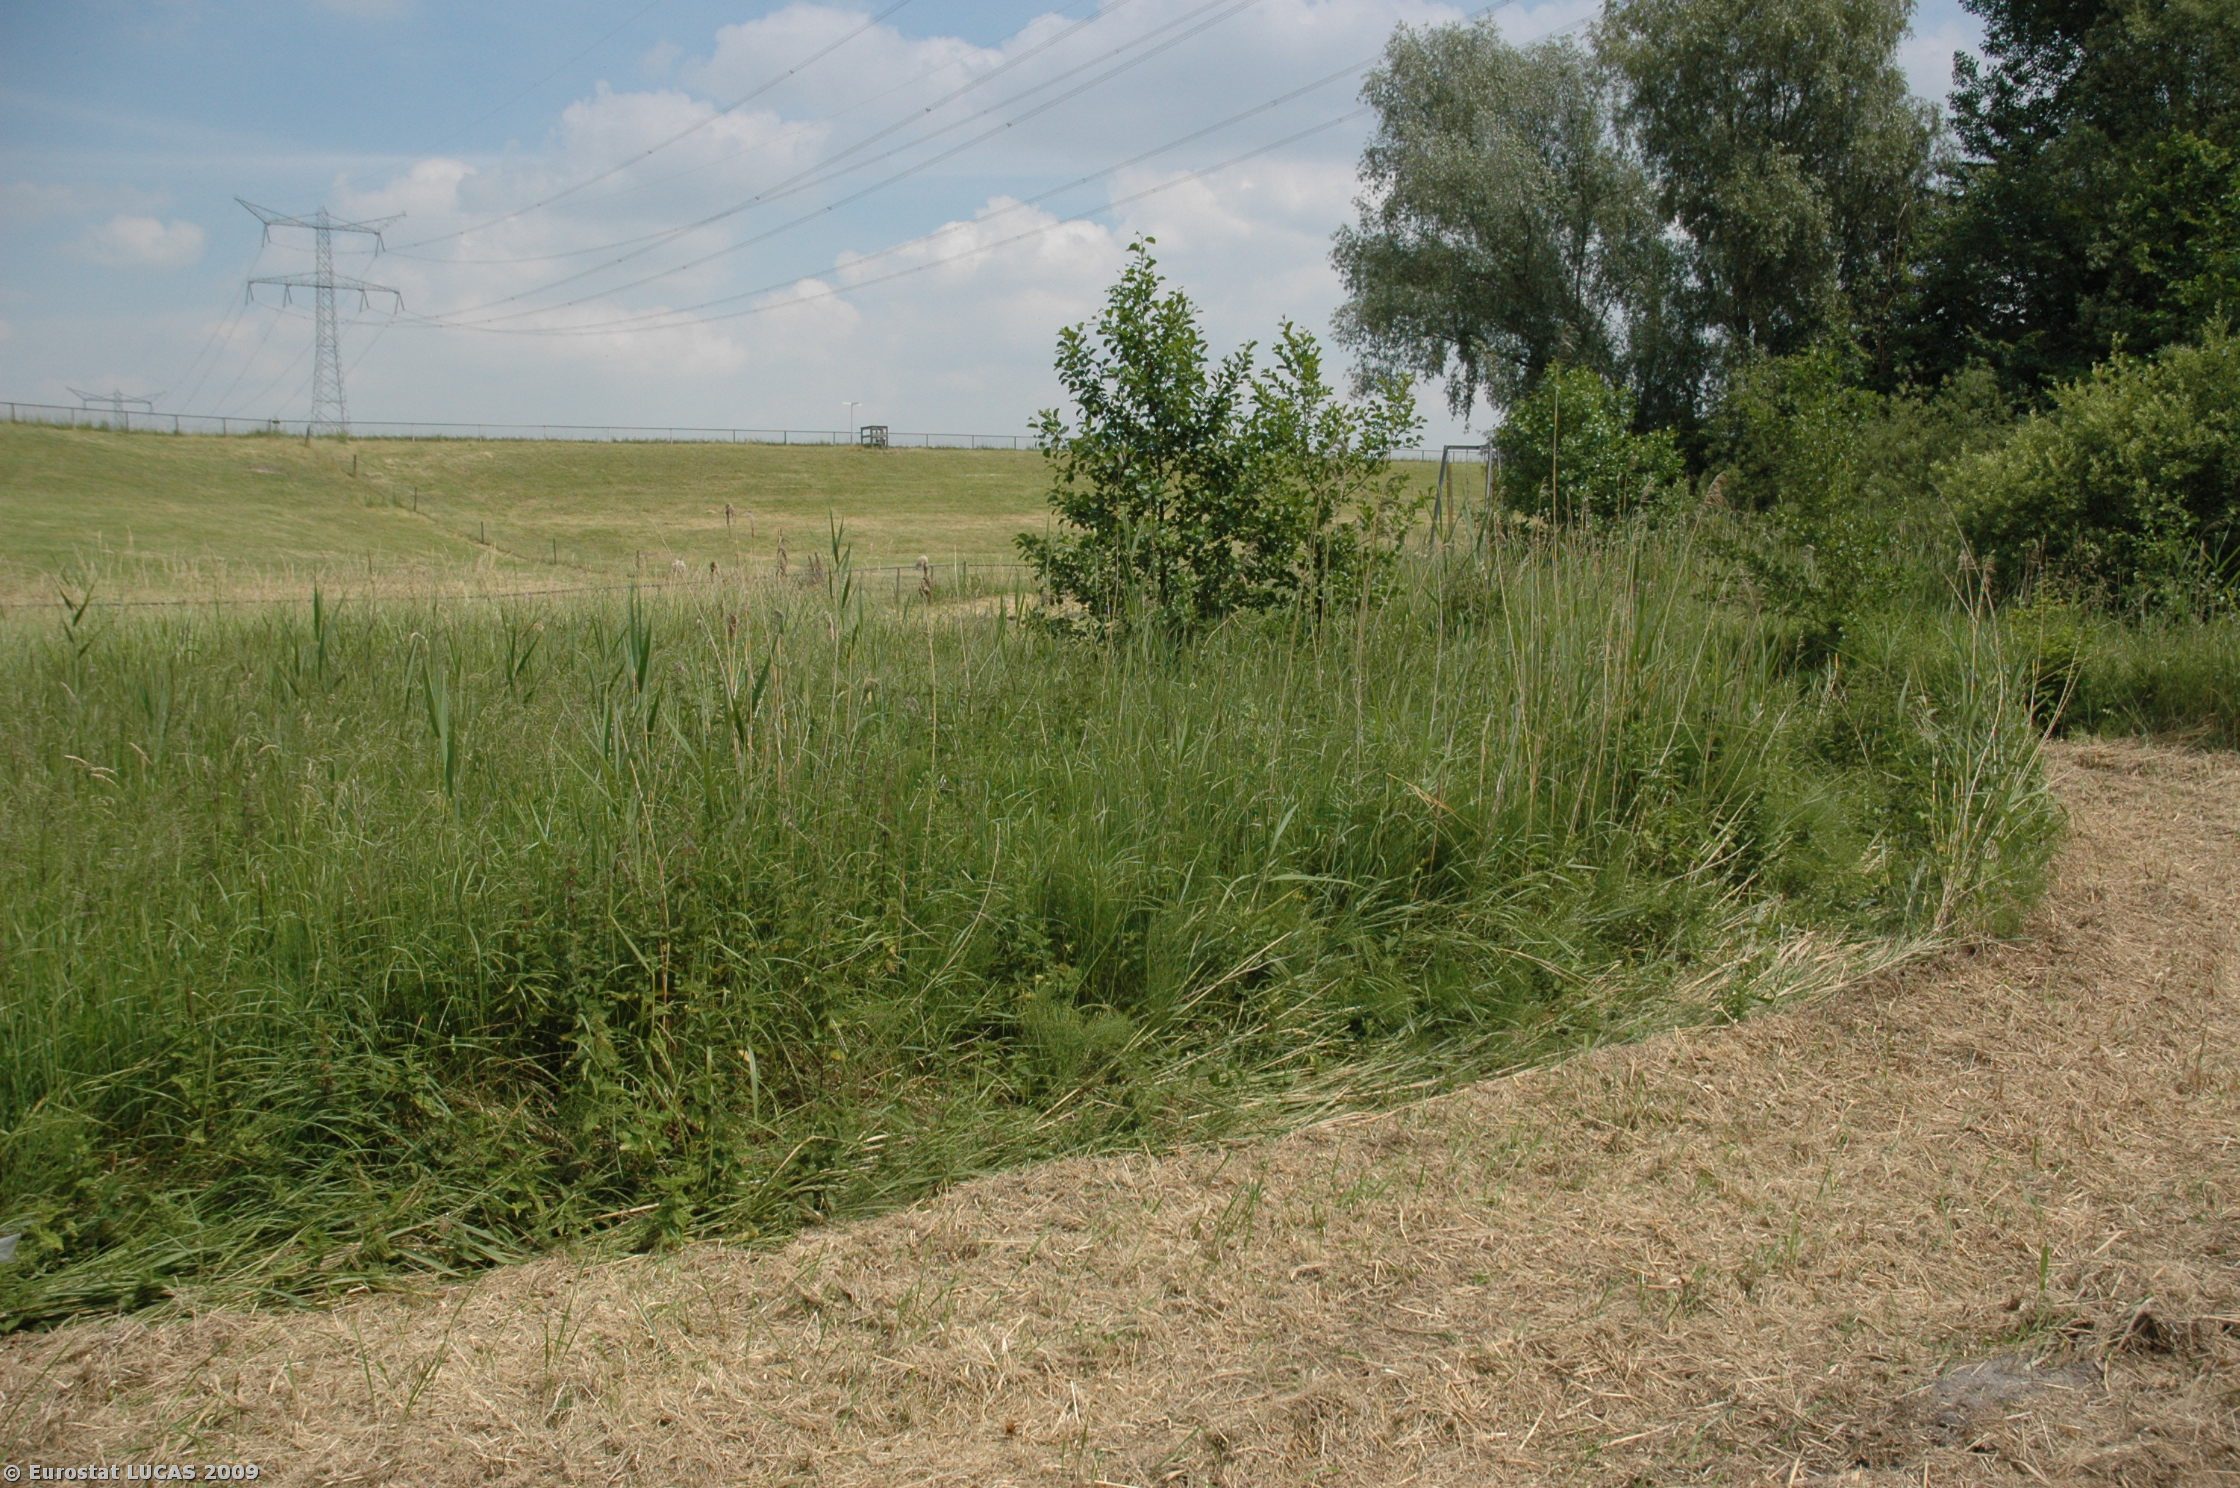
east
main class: Woodland
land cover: Broadleaved woodland
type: non-riverine alder, birch or aspen forest
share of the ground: > 75 %
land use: Unused
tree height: > 5 m
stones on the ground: < 10 %
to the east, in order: Broadleaved woodland; Grassland without tree/shrub cover; Ditches and canals; Fences; Grassland without tree/shrub cover; Fences; Grass margins; Paved roads, cycling and walking lanes; Grassland without tree/shrub cover; Electric lines; Tracks; Shruby margins; Inland water bodies
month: June
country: NL
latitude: 52.6036
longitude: 5.6429
